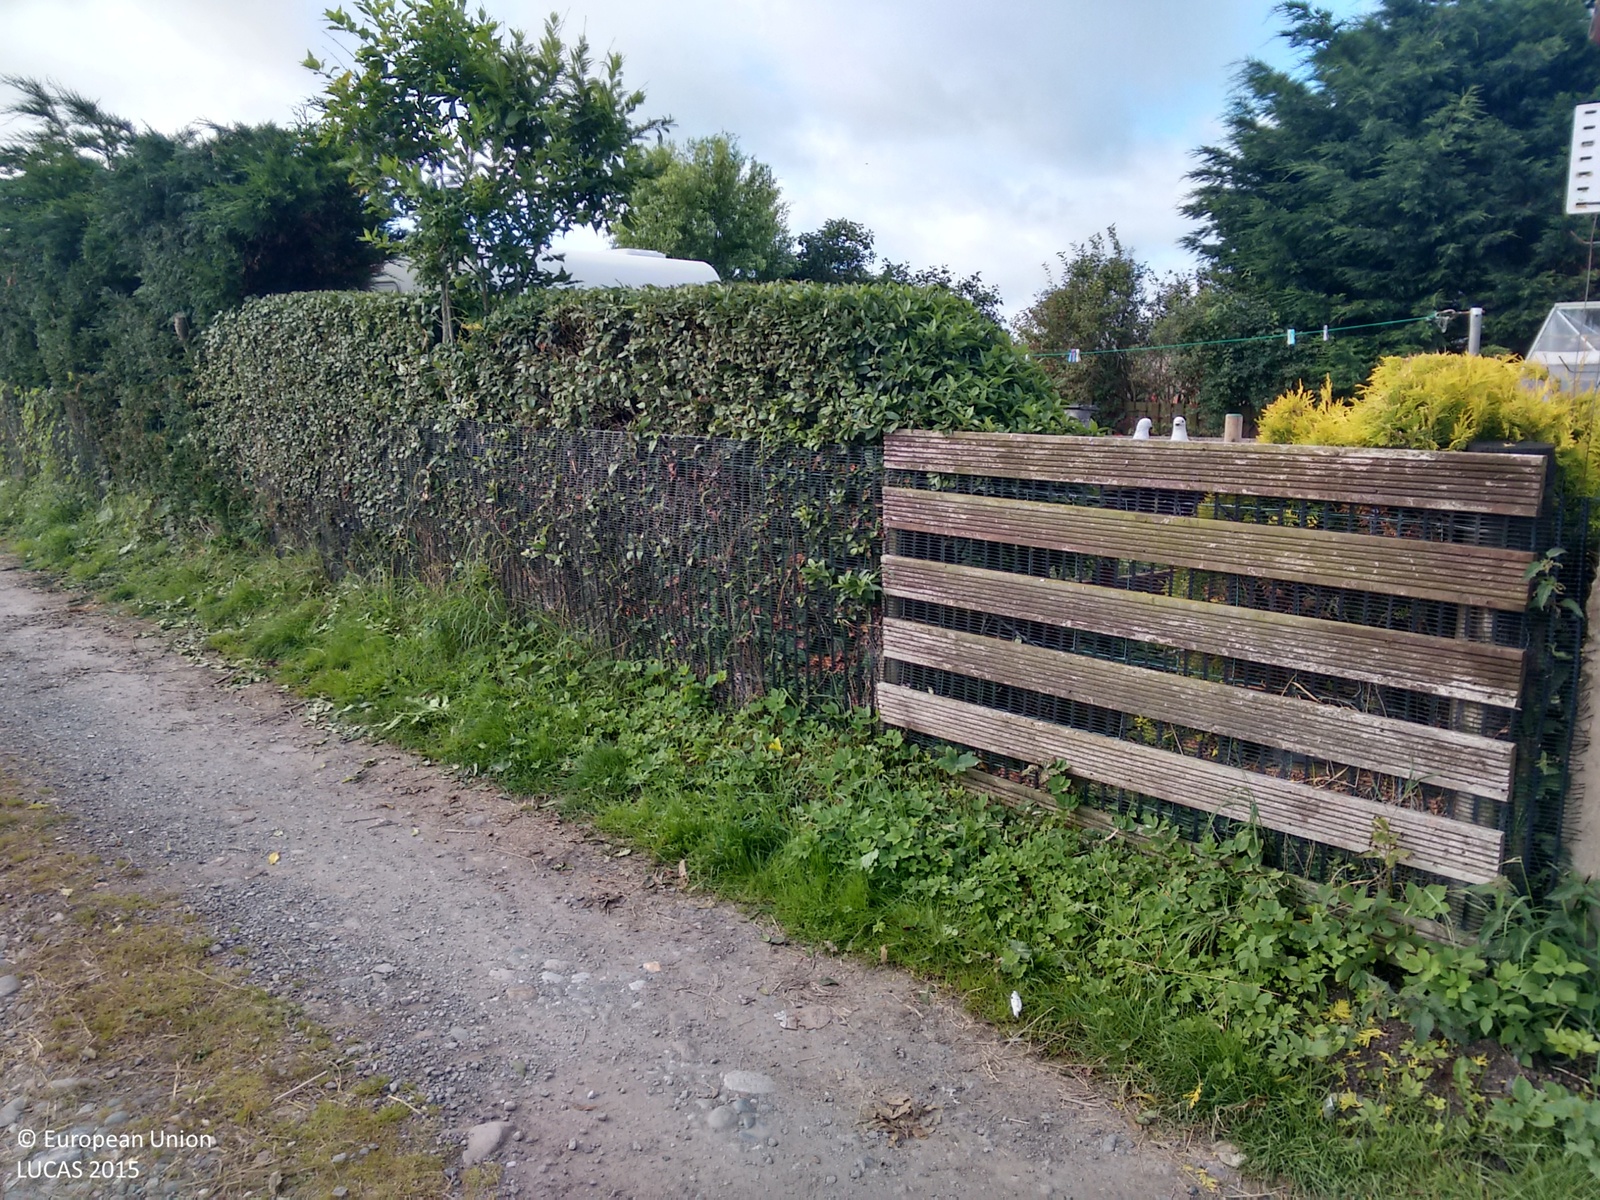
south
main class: Grassland
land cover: Spontaneously vegetated surfaces
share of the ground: > 75 %
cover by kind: herbaceous plants 100 %
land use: Fallow land
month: August
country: GB
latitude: 54.6817
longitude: -3.5295
